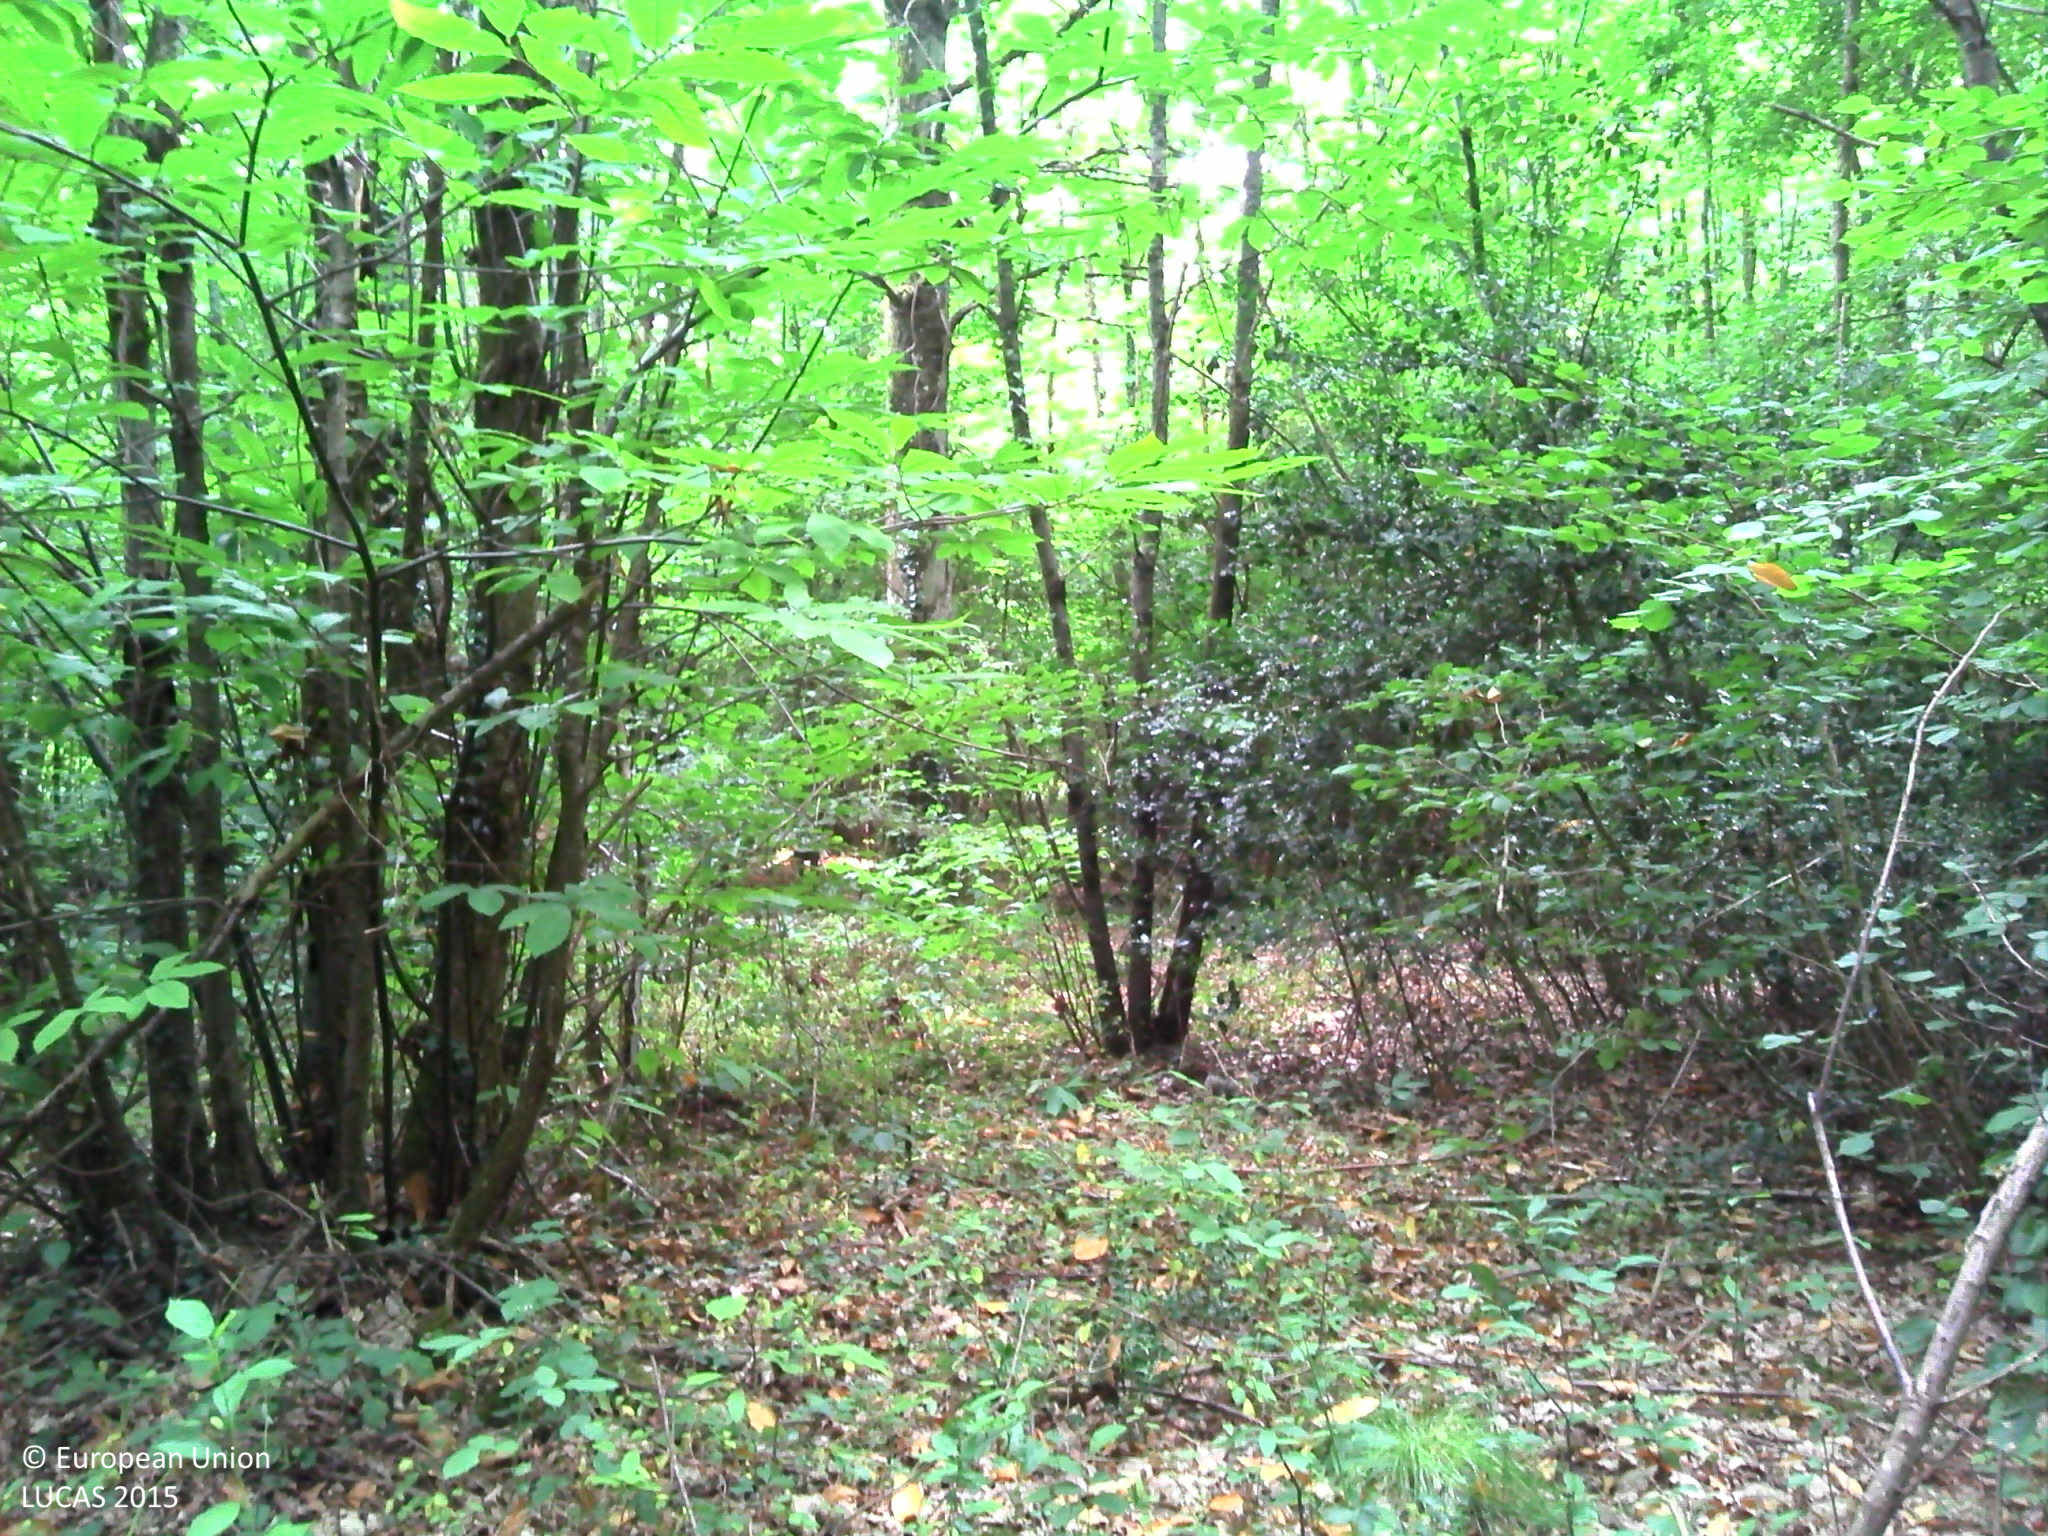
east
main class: Woodland
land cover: Broadleaved woodland
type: acidophilous oak and oak-birch forest
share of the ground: > 75 %
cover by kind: broadleaved forest trees 85 %, shrubs 10 %, herbaceous plants 5 %
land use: Forestry
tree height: > 5 m
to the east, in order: Broadleaved woodland; Ditches and canals; Paved roads, cycling and walking lanes; Grass margins; Ditches and canals; Broadleaved woodland; Tracks; Grass margins; Broadleaved woodland
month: July
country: FR
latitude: 46.4494
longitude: 0.2562
